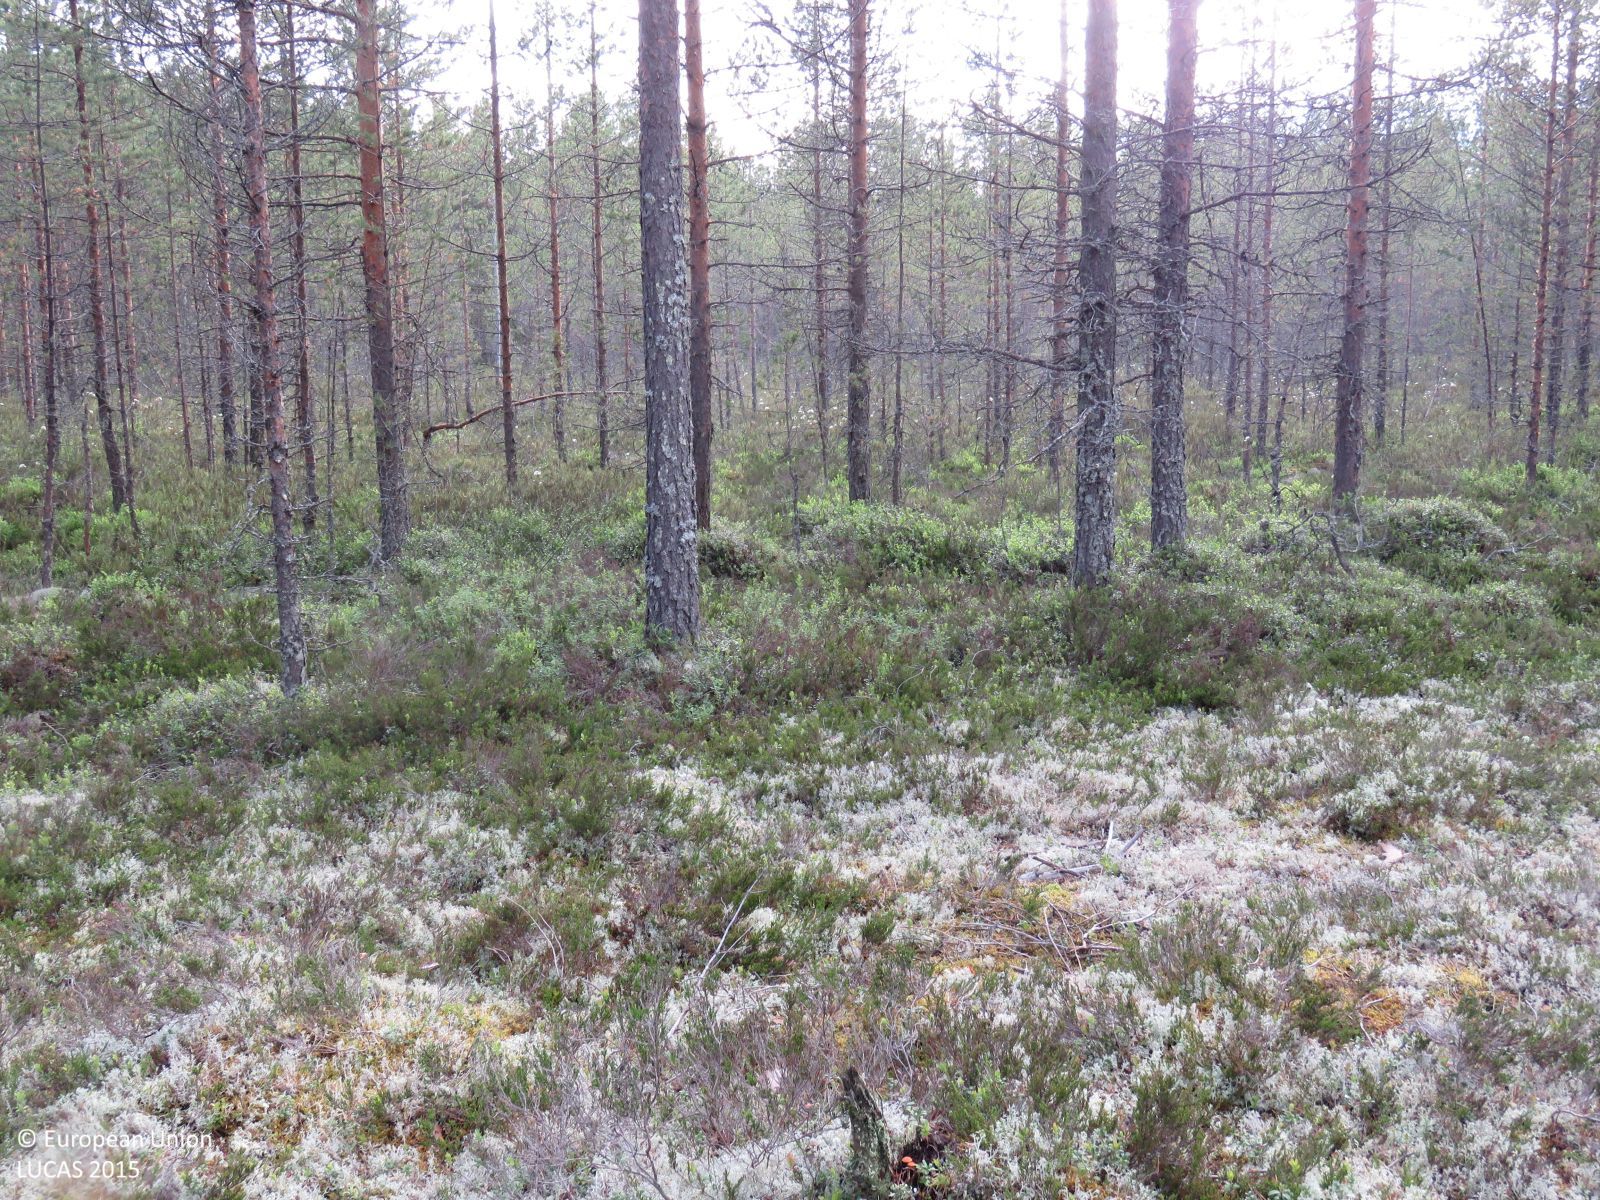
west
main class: Woodland
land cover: Pine dominated coniferous woodland
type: boreal forest
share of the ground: 25 - 50 %
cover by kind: coniferous forest trees 40 %, shrubs 40 %, lichens and mosses 20 %
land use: Forestry
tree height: > 5 m
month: June
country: FI
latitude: 64.0984
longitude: 26.5138
